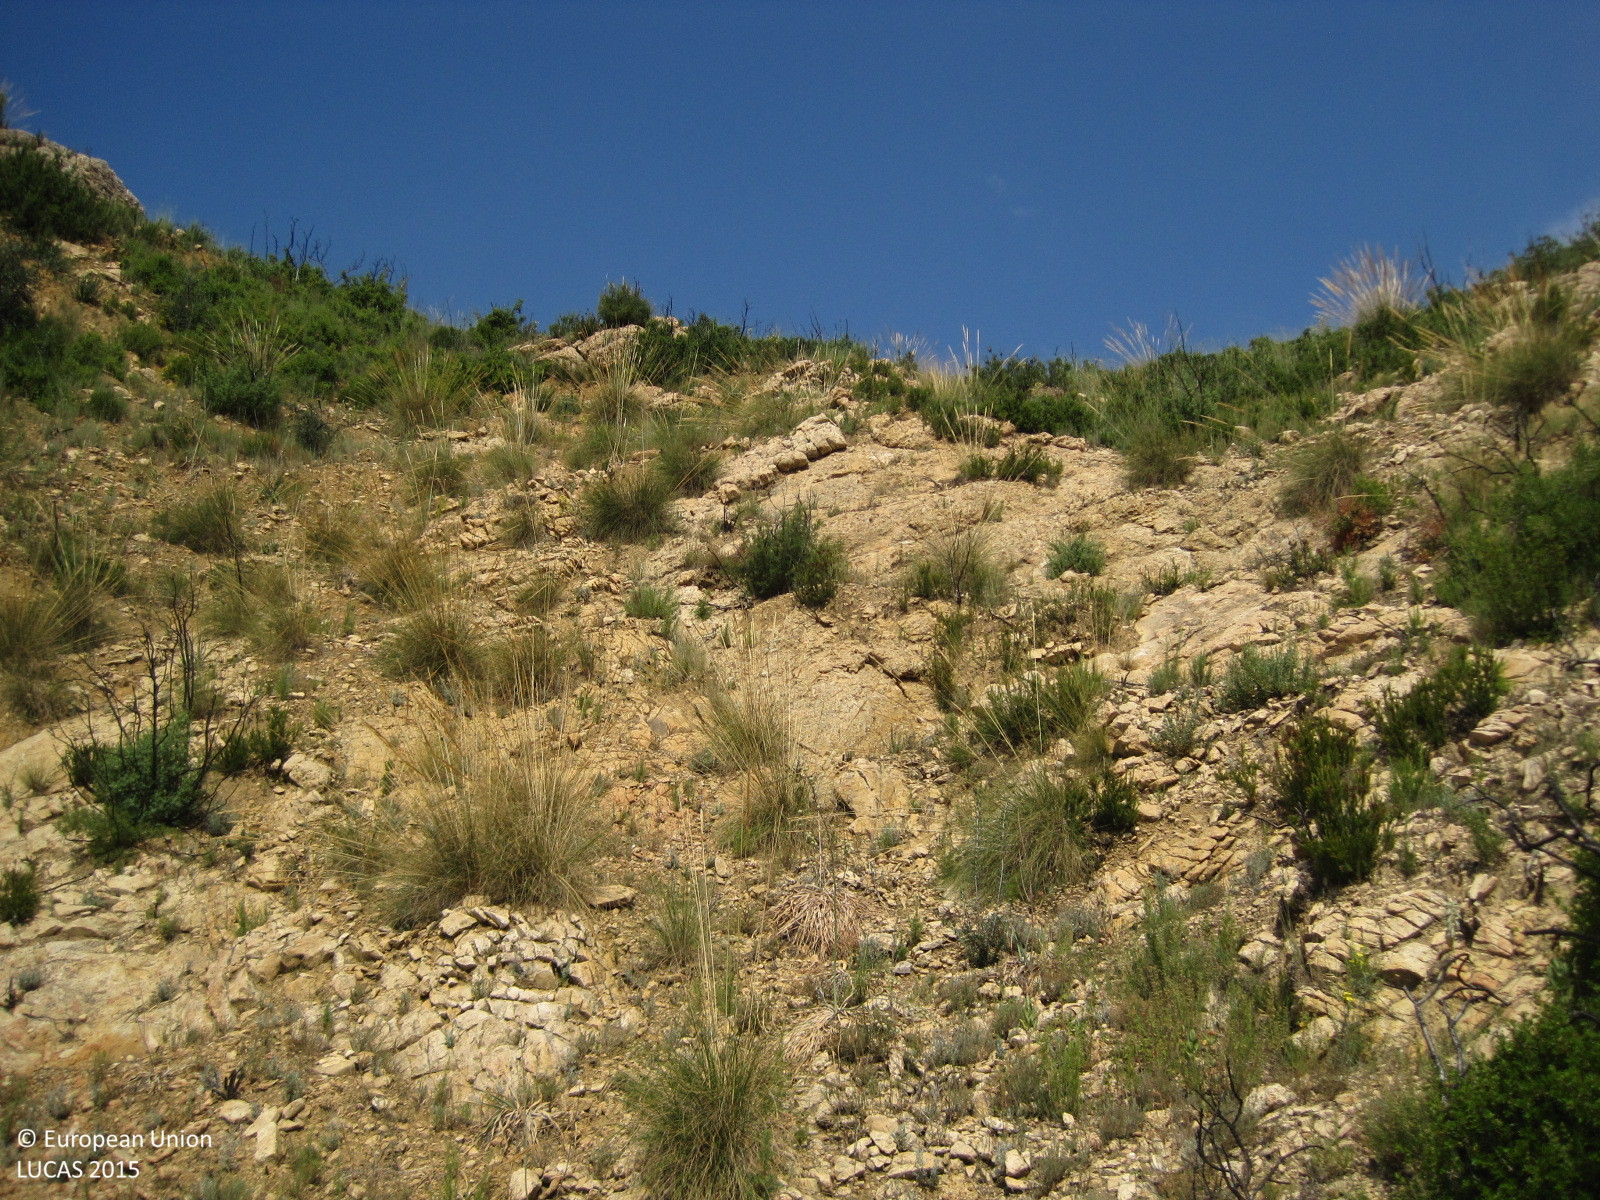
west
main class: Grassland
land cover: Grassland with sparse tree/shrub cover
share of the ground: > 75 %
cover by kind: herbaceous plants 85 %, shrubs 10 %, broadleaved forest trees 5 %
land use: Semi-natural and natural areas not in use
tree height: < 5 m
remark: Burnt area
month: June
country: ES
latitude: 39.3000
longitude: -0.8398
